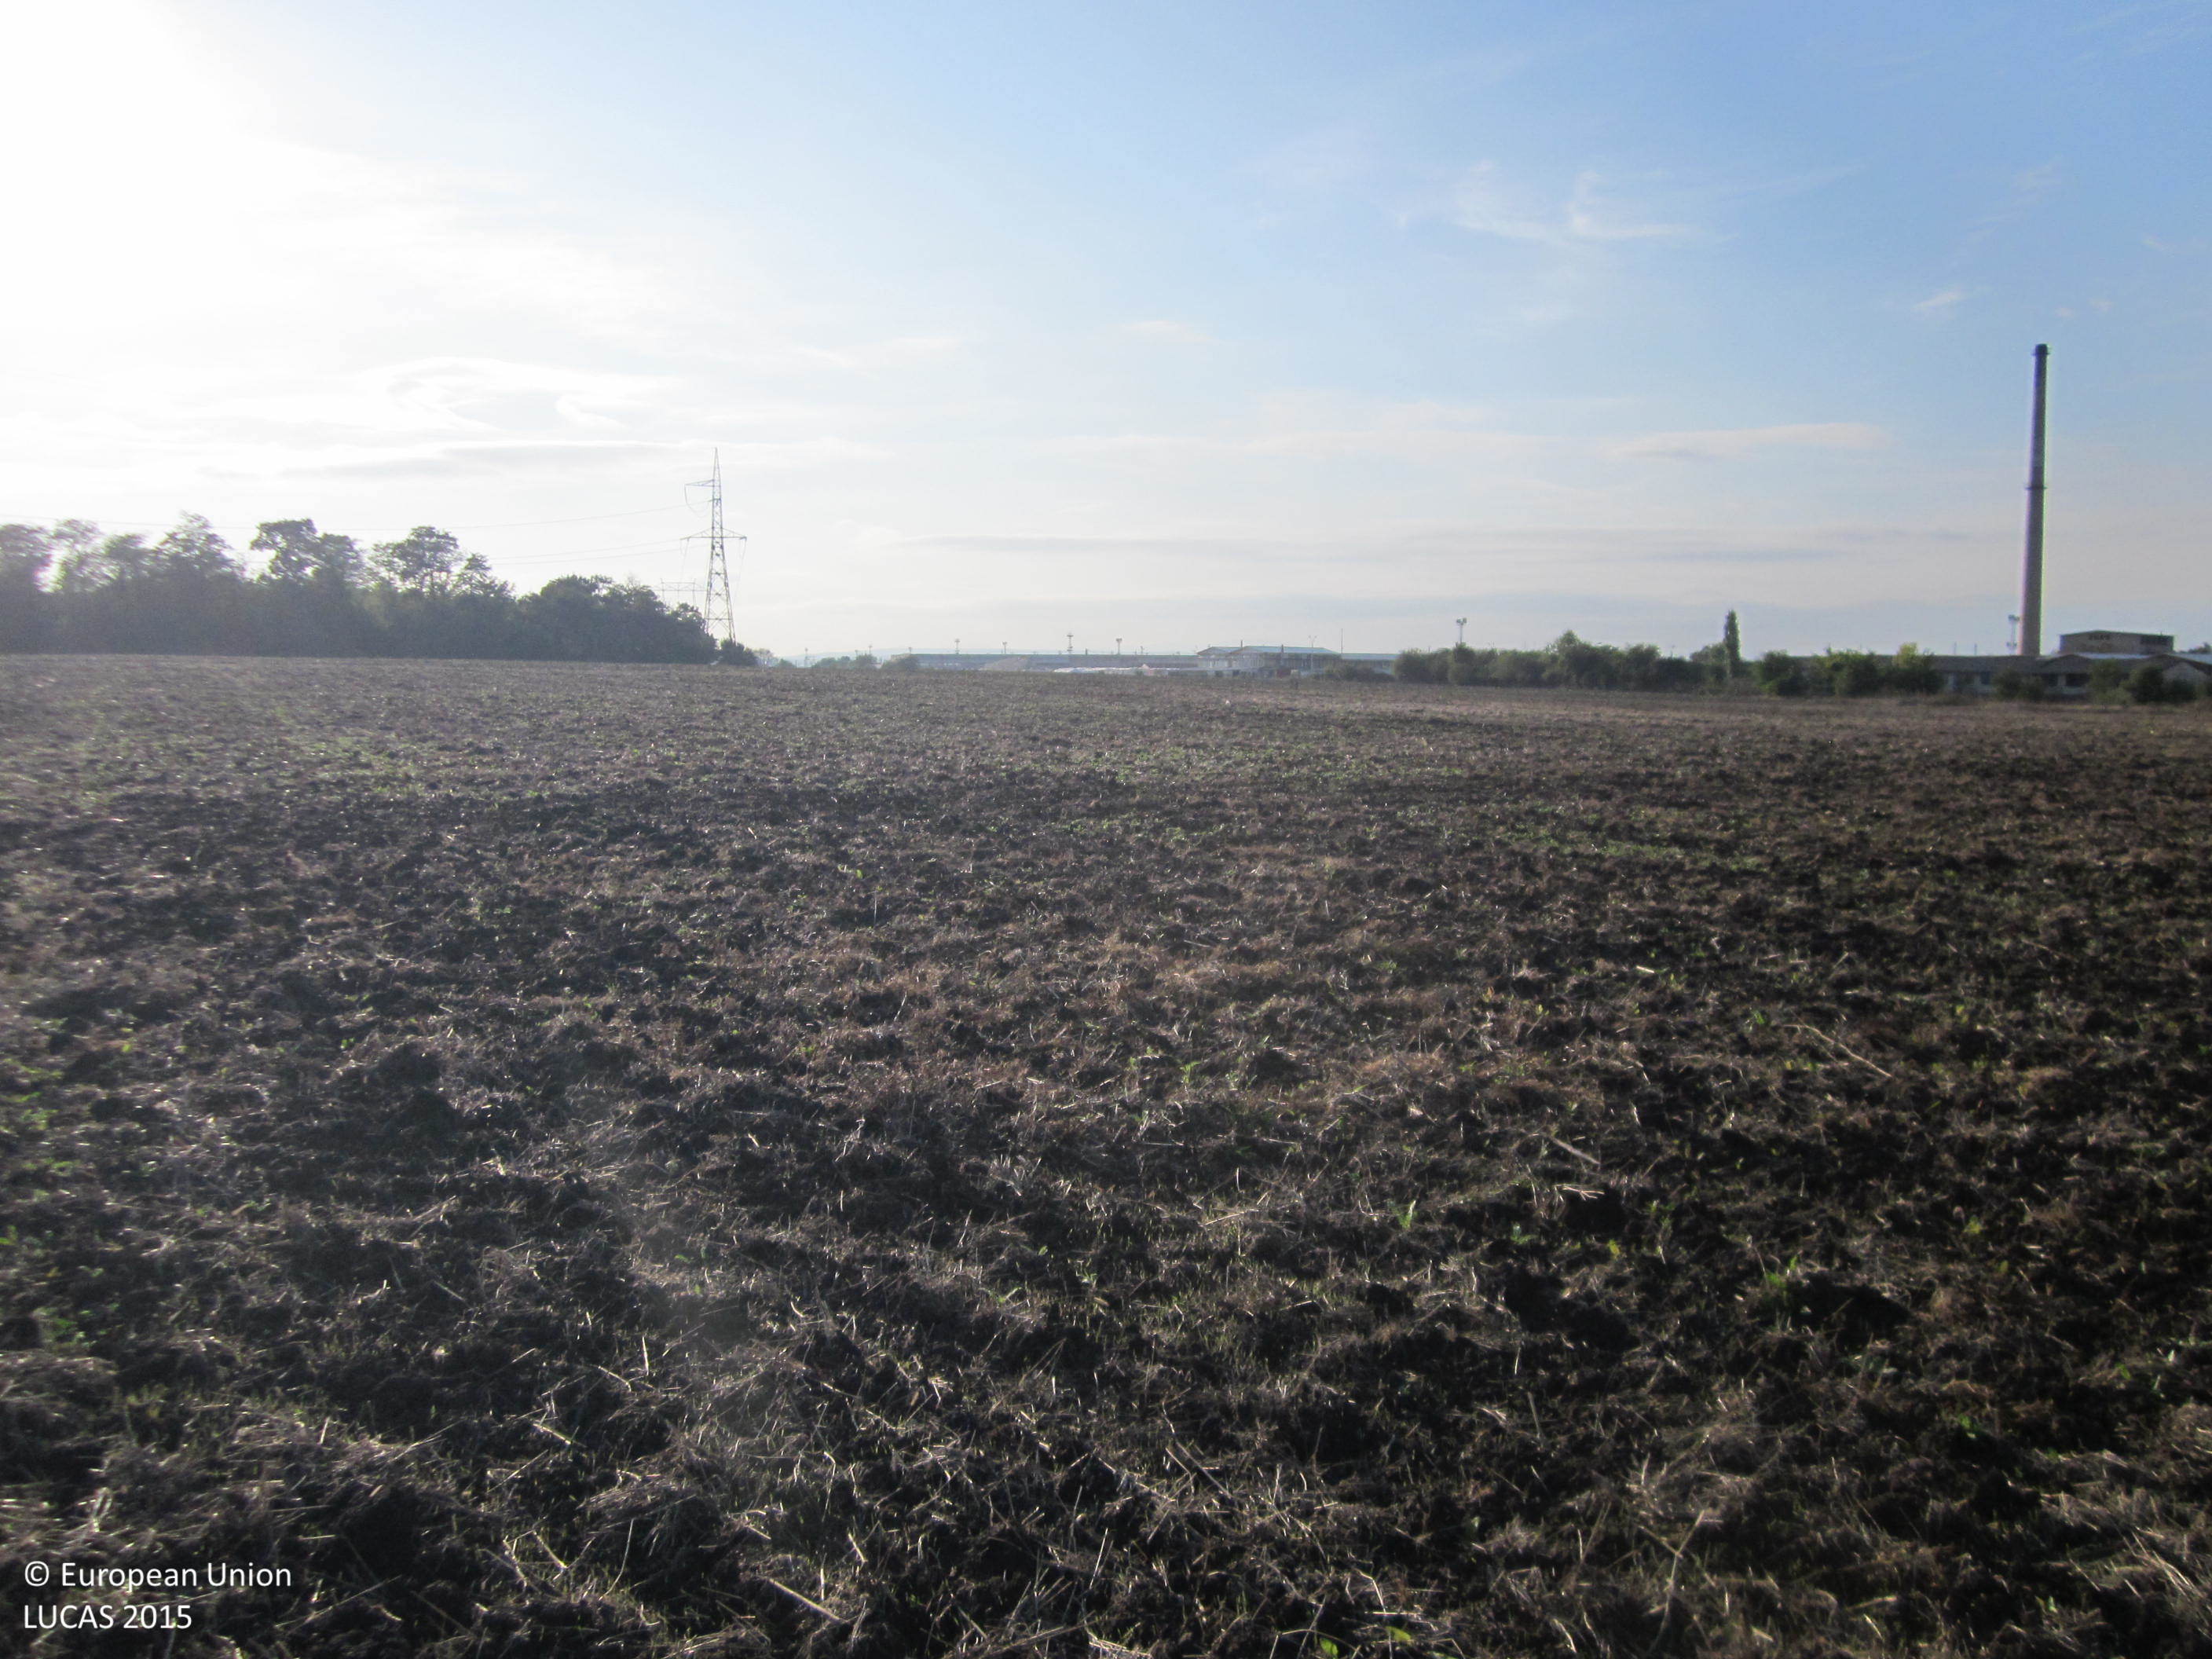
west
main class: Cropland
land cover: Common wheat
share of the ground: < 10 %
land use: Agriculture (excluding fallow land and kitchen gardens)
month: October
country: BG
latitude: 42.6627
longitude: 26.9791
